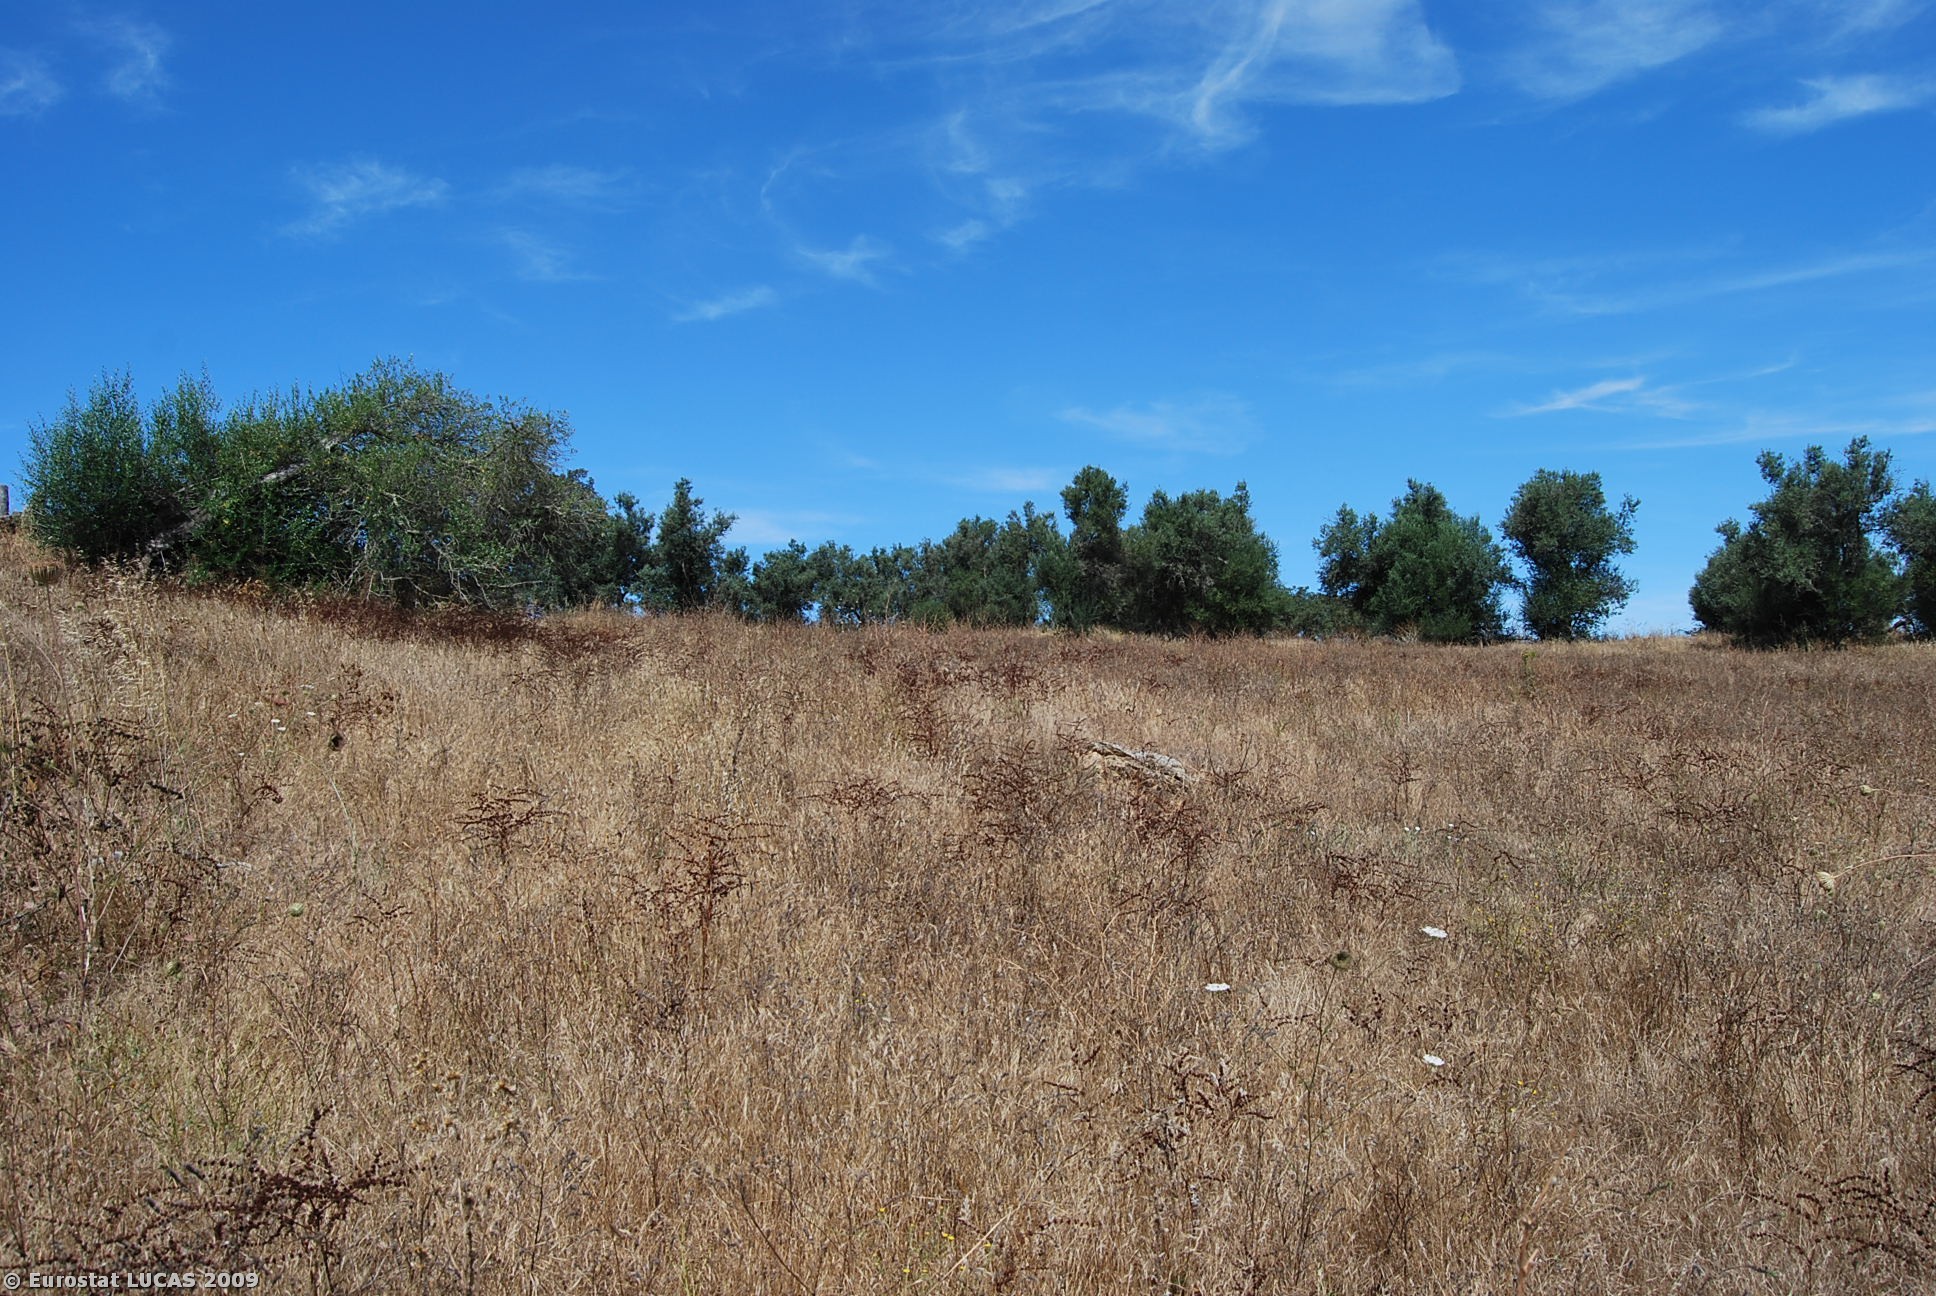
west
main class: Grassland
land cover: Grassland with sparse tree/shrub cover
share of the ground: 50 - 75 %
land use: Fallow land
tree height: > 5 m
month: July
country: PT
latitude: 37.7180
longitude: -8.2852
